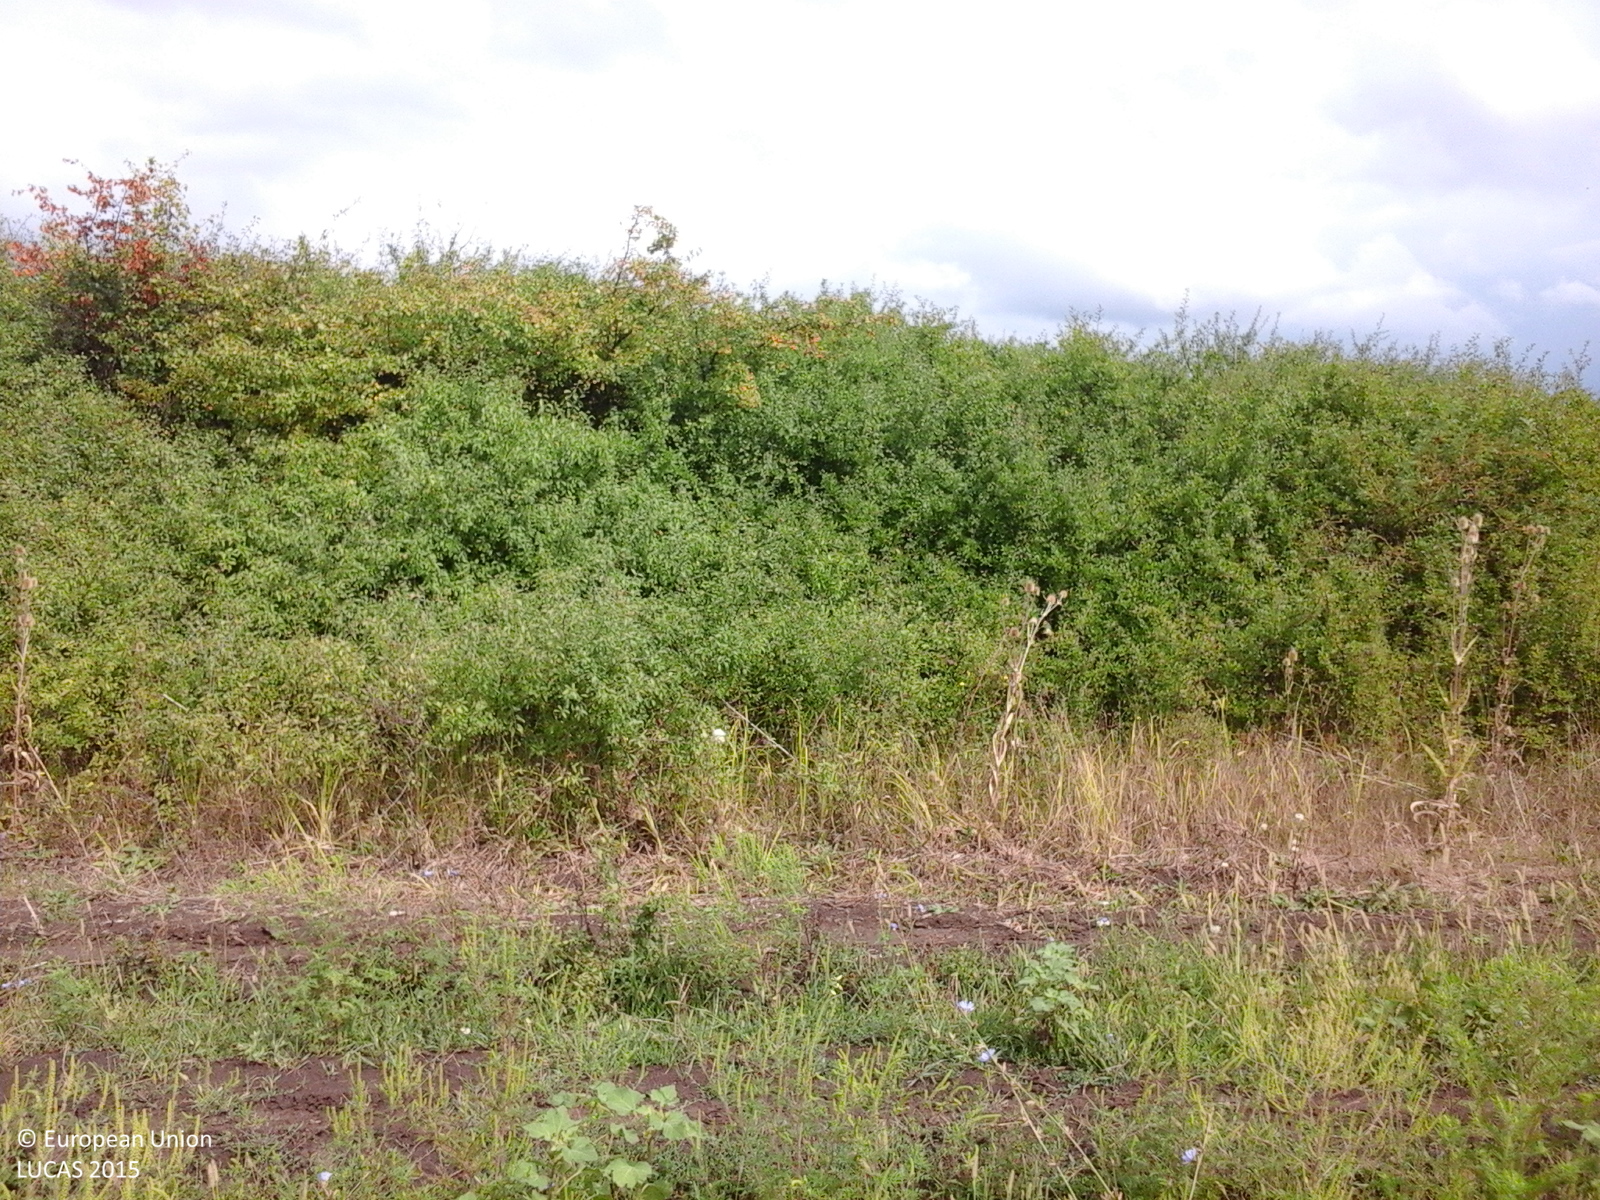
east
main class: Cropland
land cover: Common wheat
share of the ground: 10 - 25 %
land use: Agriculture (excluding fallow land and kitchen gardens)
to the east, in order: Common wheat; Grass margins; Tracks; Abandoned hedges; Ditches and canals; Abandoned hedges; Spontaneously vegetated surfaces
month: August
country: RO
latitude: 45.7717
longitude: 21.4396
